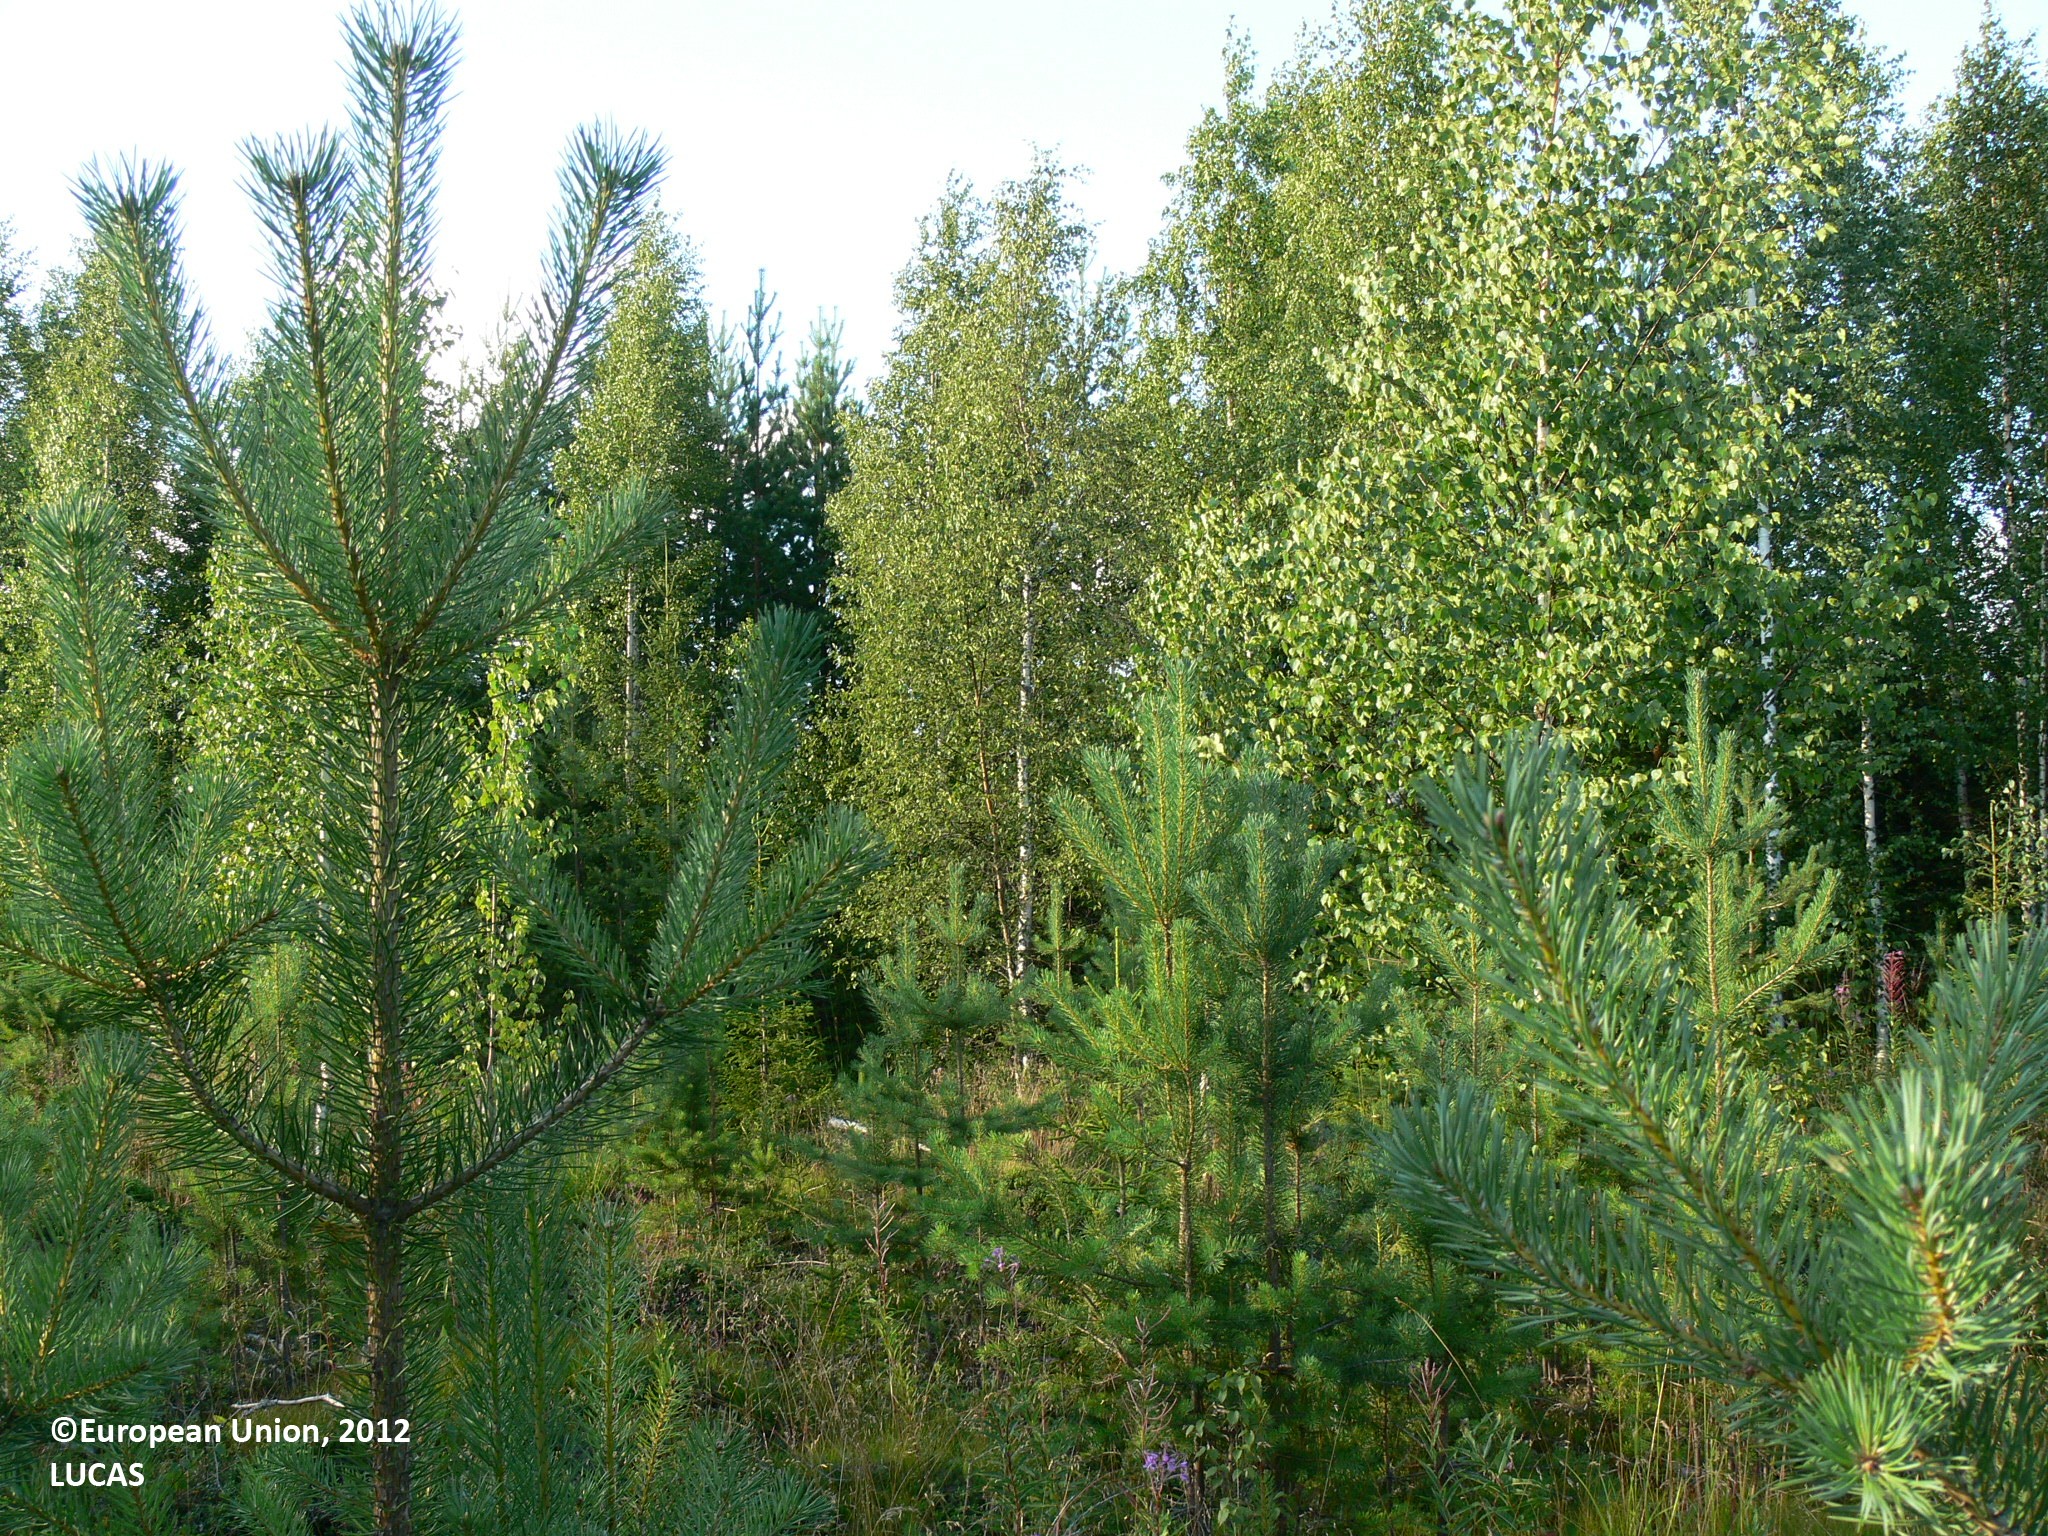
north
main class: Woodland
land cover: Pine dominated mixed woodland
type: boreal forest
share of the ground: 25 - 50 %
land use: Forestry
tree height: < 5 m
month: August
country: FI
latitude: 61.9582
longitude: 29.1665
